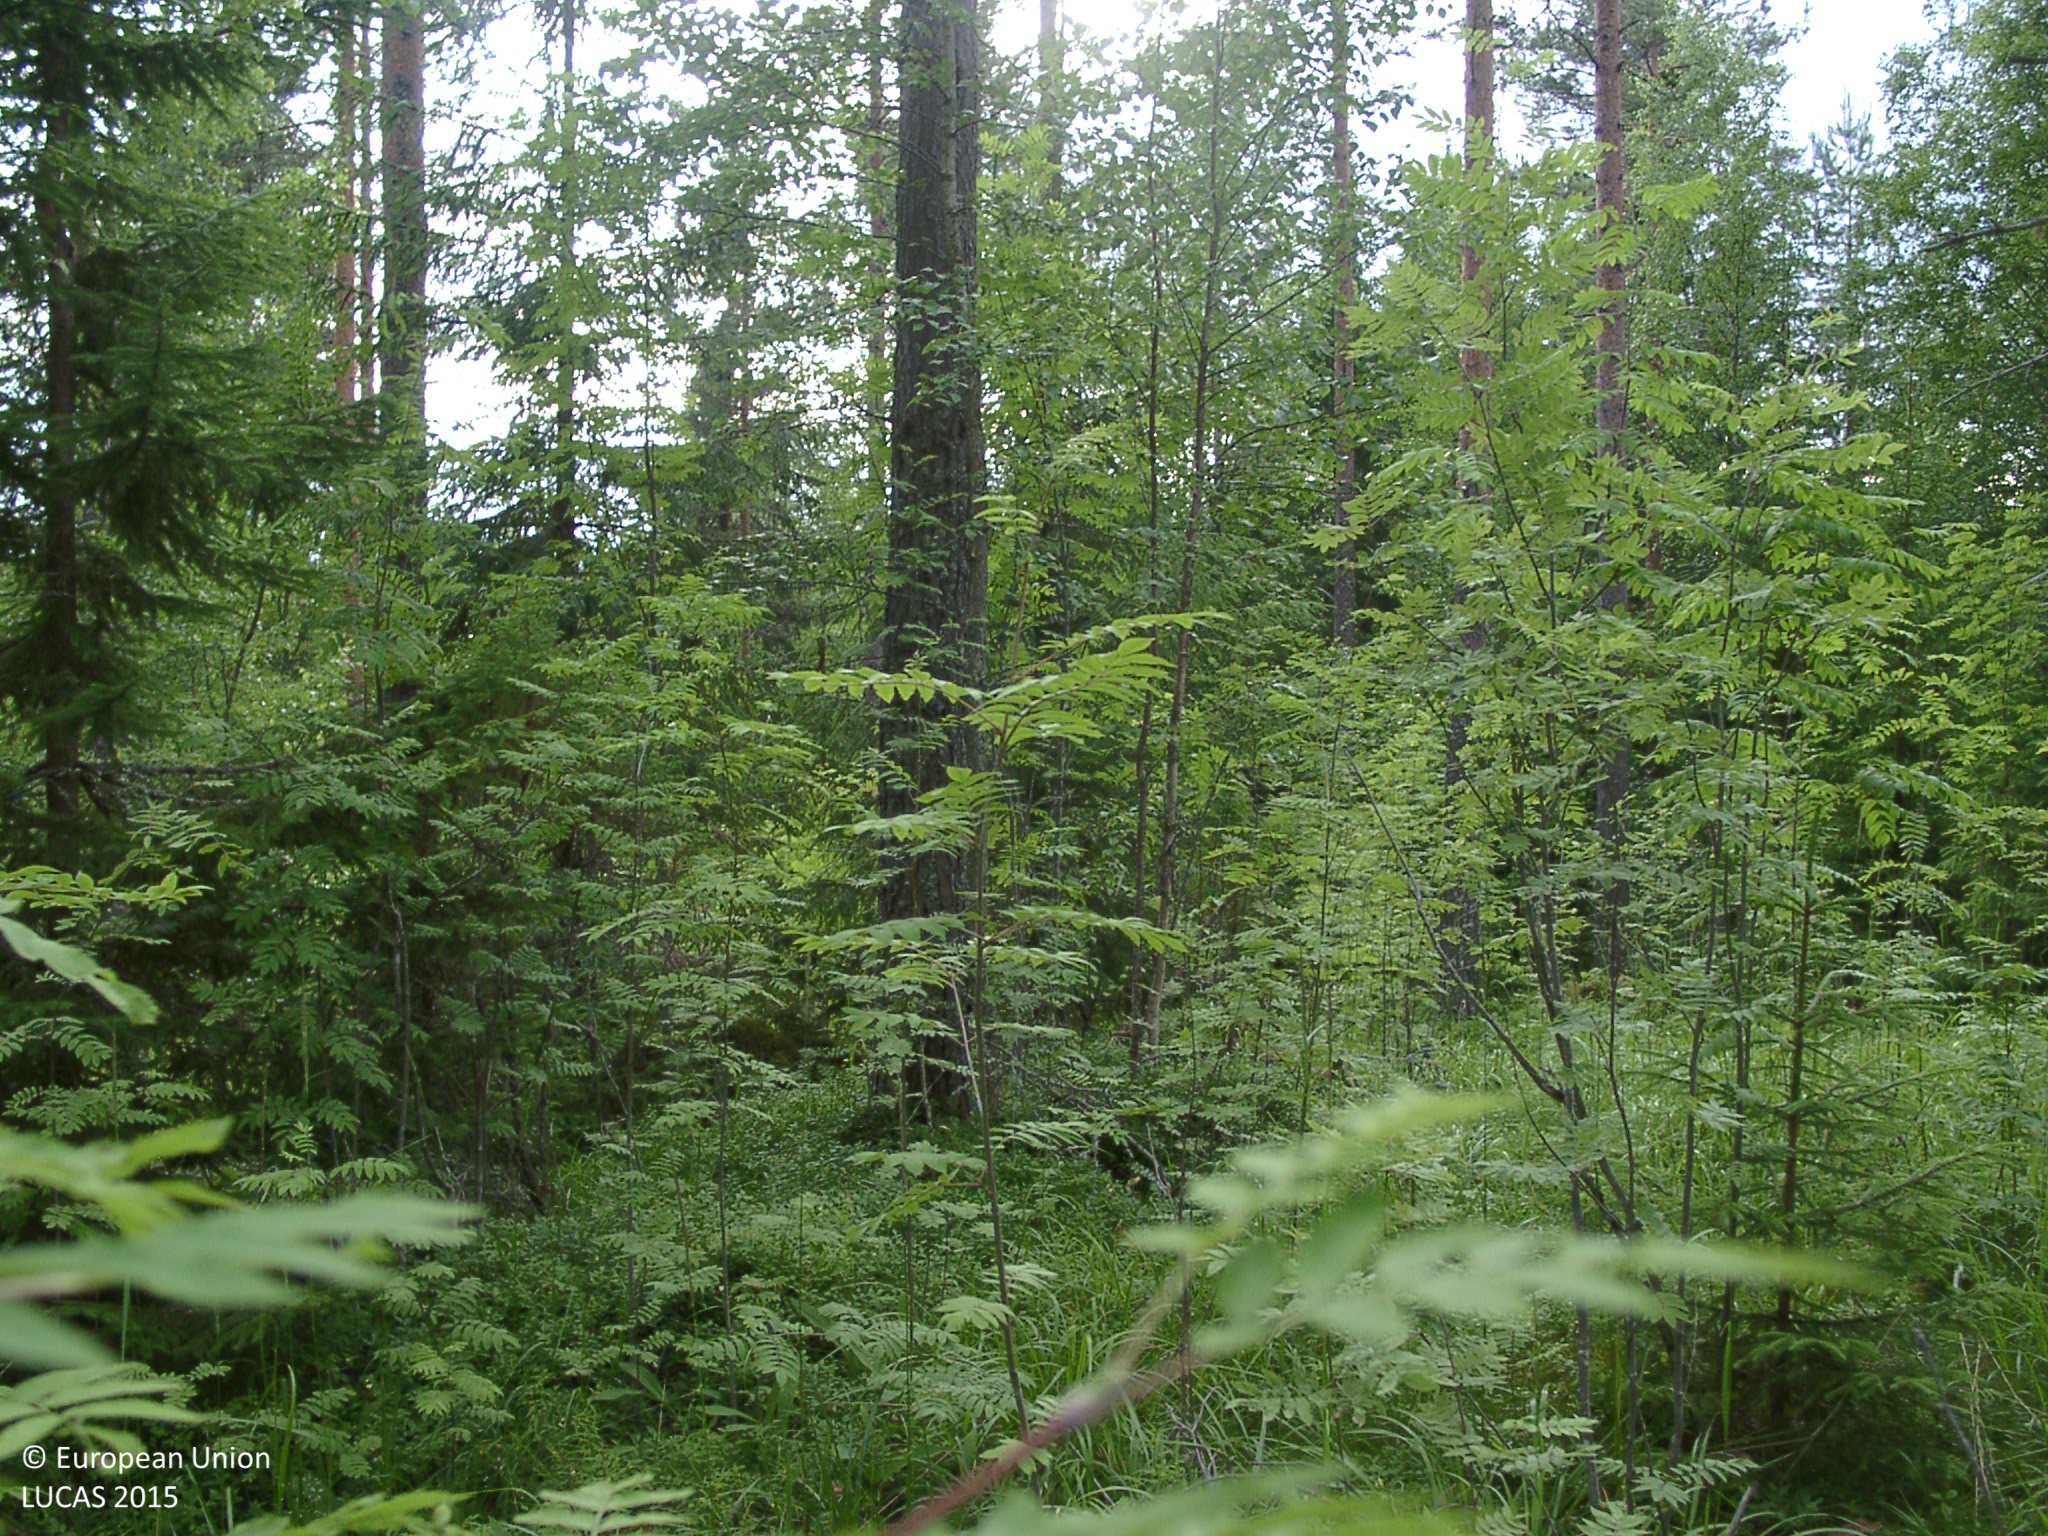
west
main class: Woodland
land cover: Other mixed woodland
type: boreal forest
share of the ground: 50 - 75 %
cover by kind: coniferous forest trees 50 %, broadleaved forest trees 20 %, shrubs 15 %, herbaceous plants 10 %, lichens and mosses 5 %
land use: Semi-natural and natural areas not in use
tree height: > 5 m
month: July
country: FI
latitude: 61.5800
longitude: 25.1617
